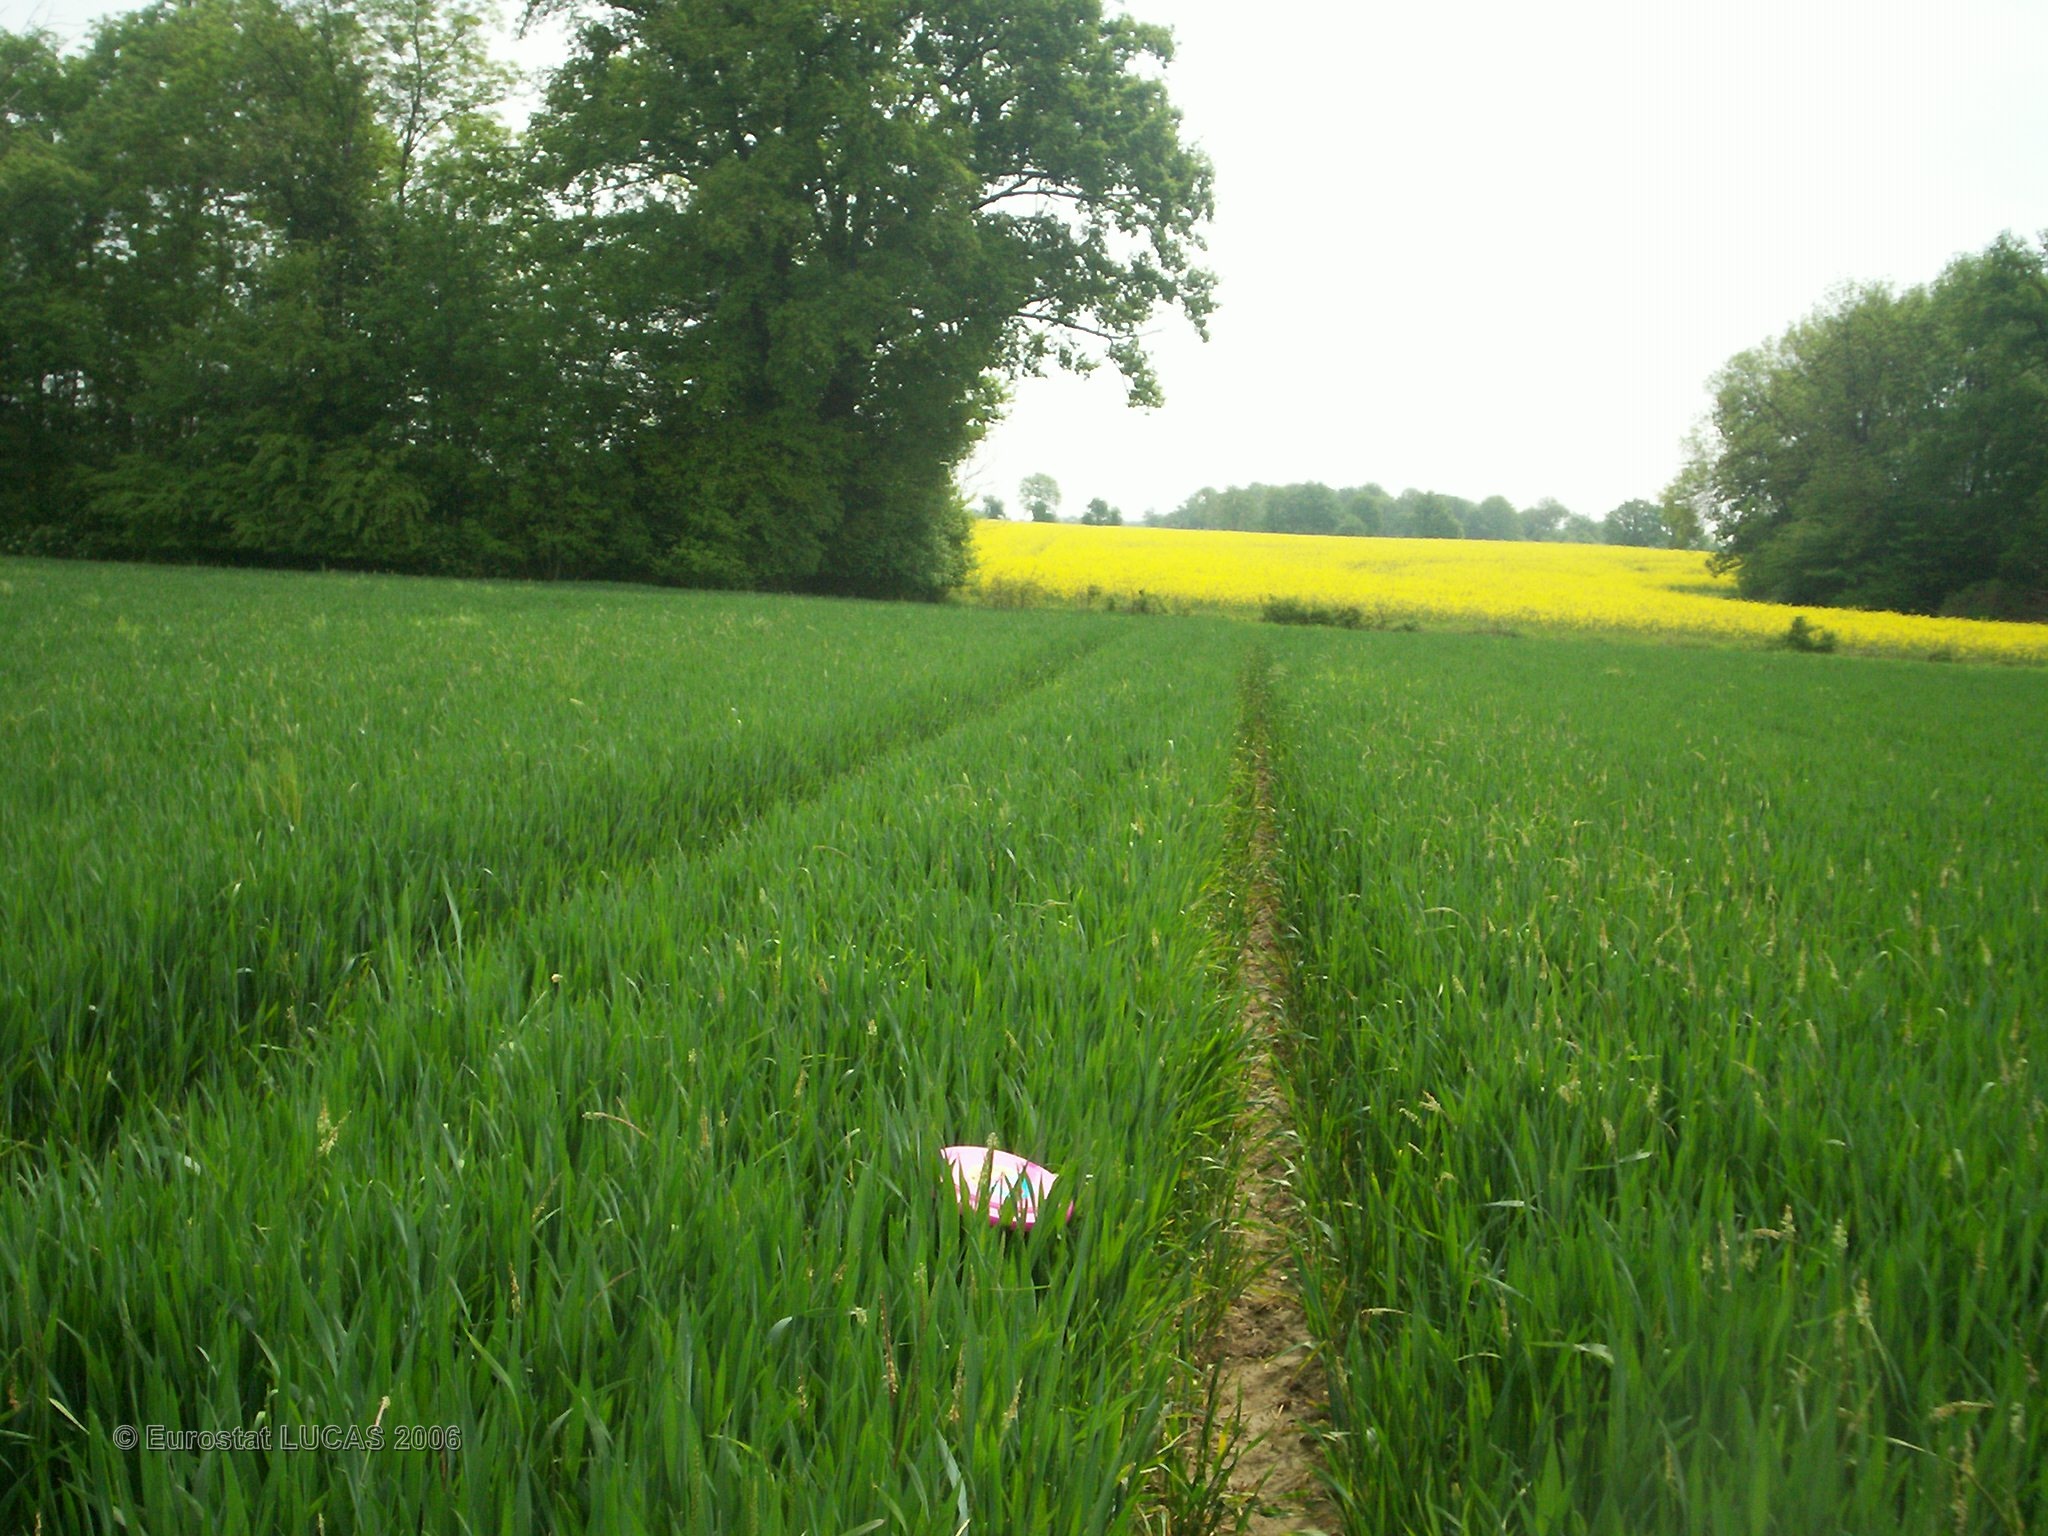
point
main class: Cropland
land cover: Common wheat
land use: Agriculture (excluding fallow land and kitchen gardens)
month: May
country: FR
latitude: 47.7637
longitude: 2.9622
